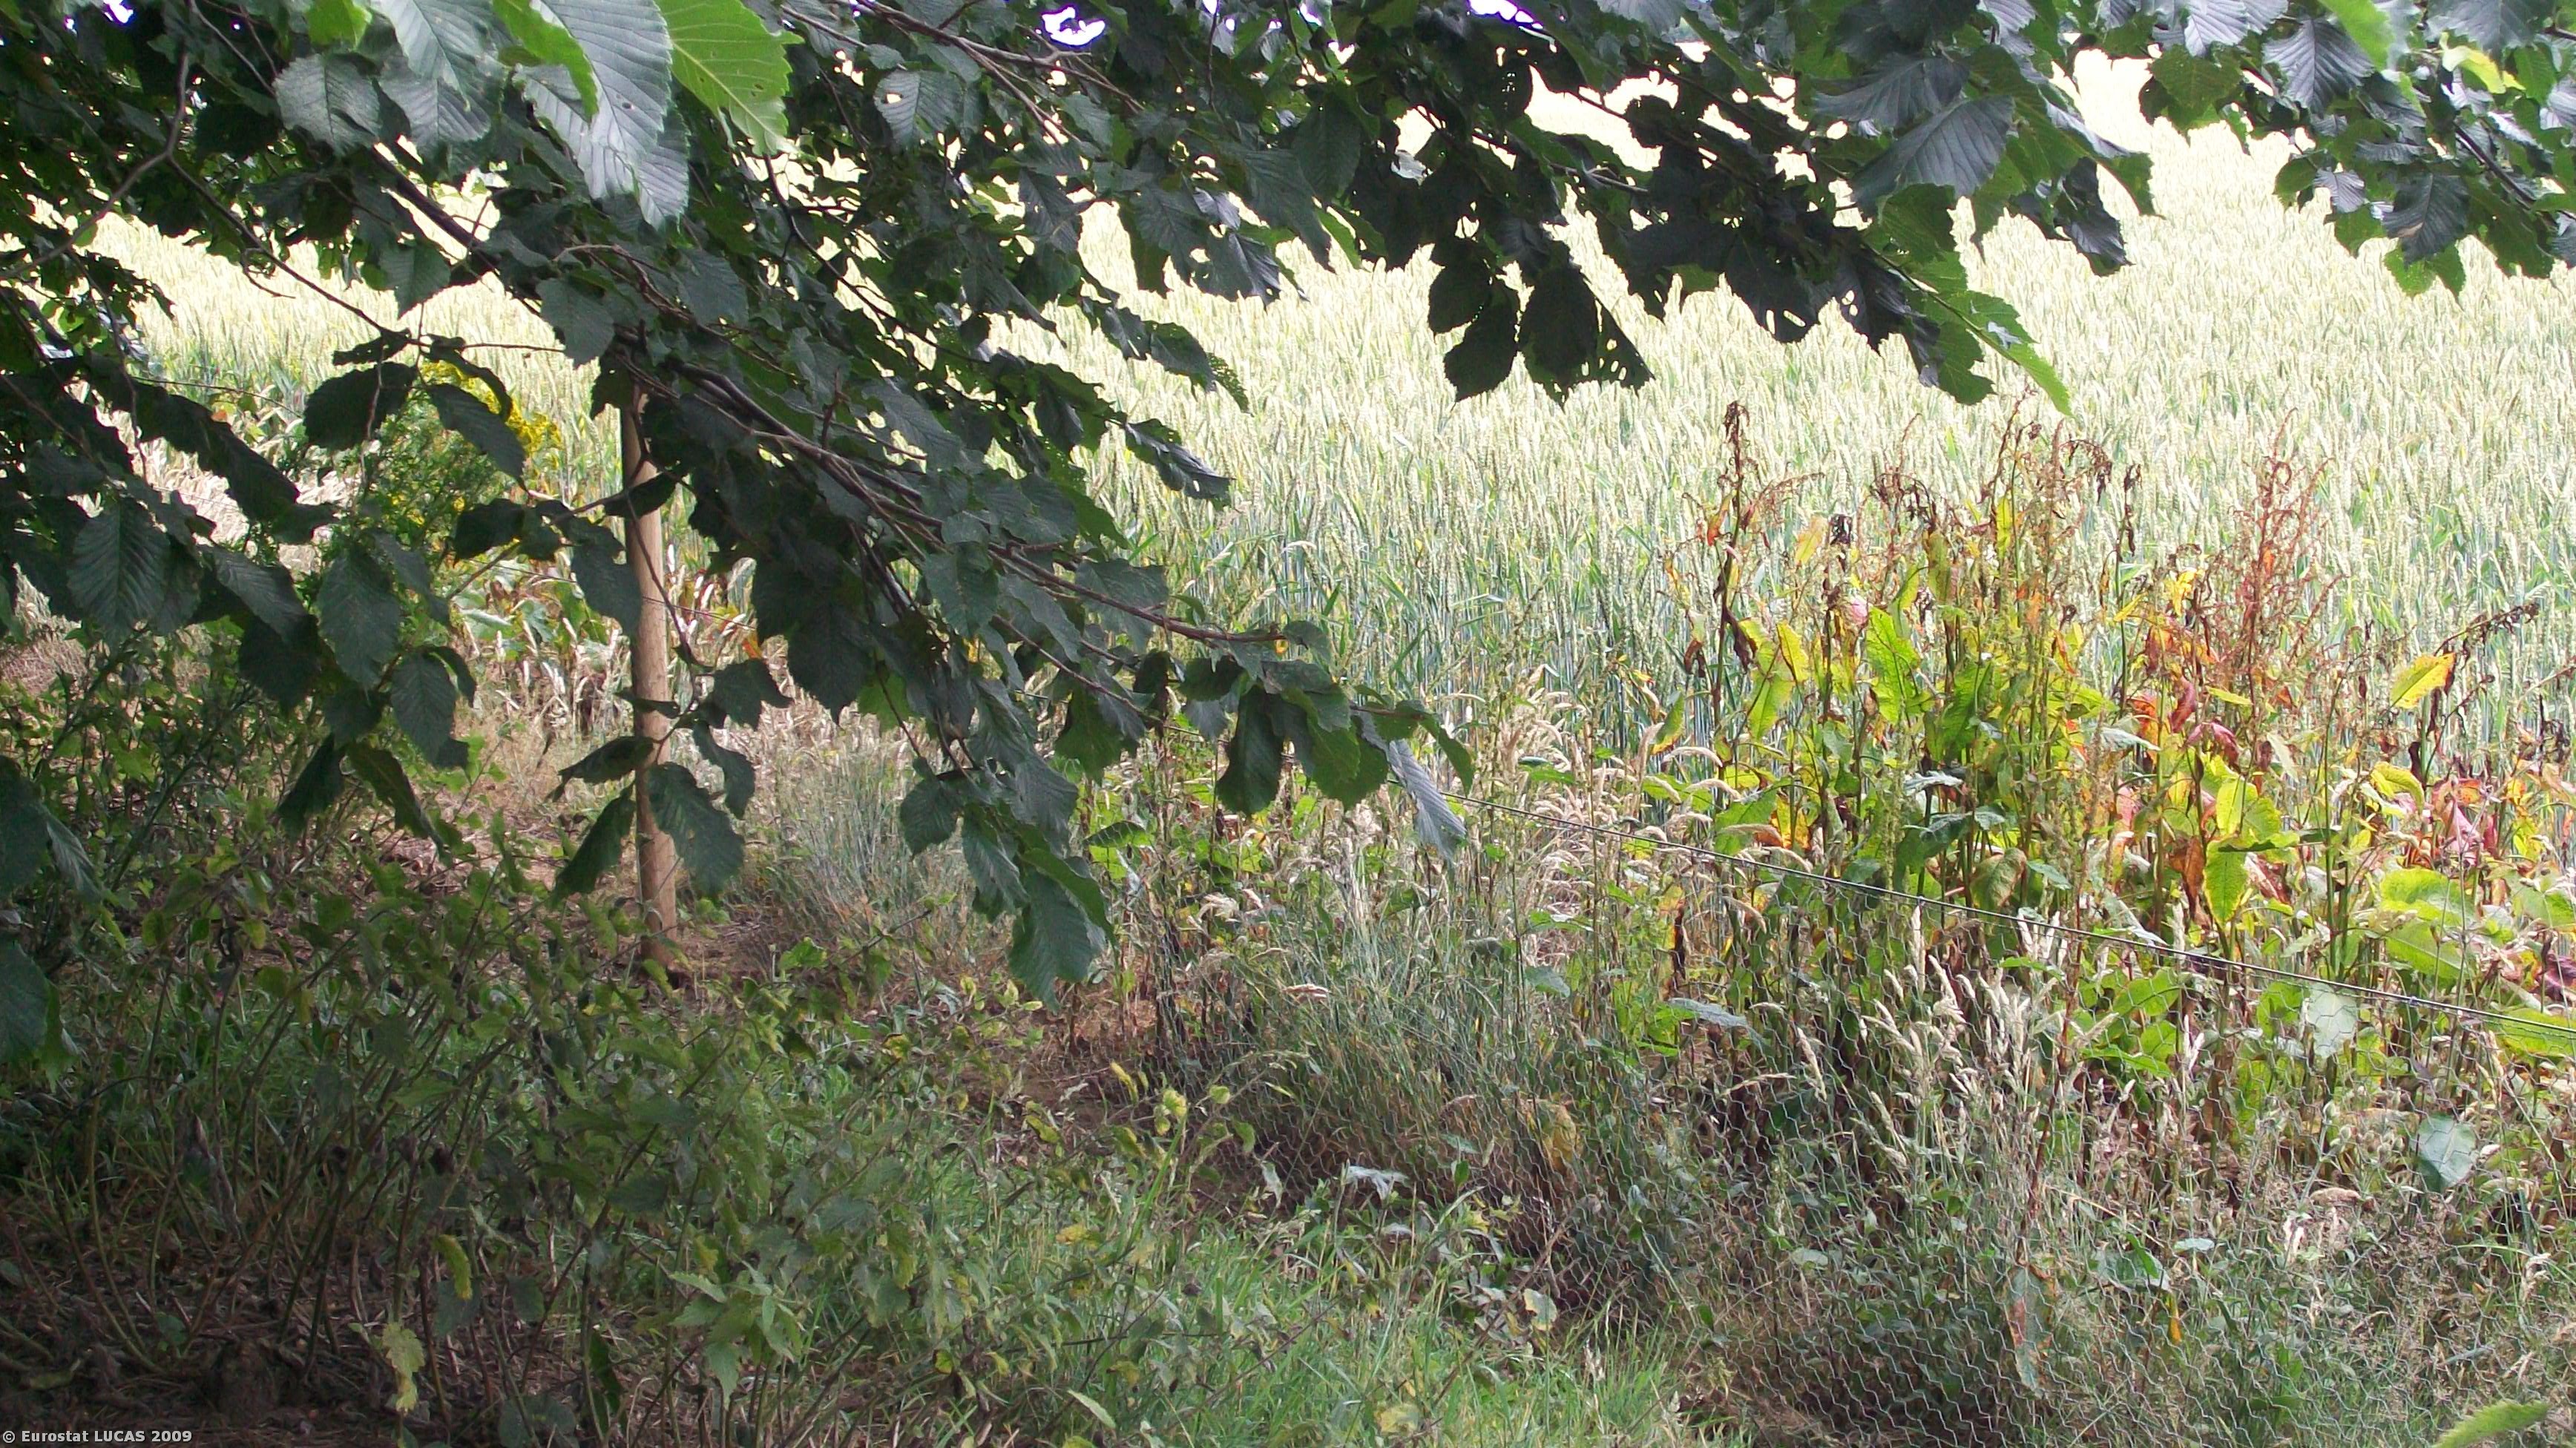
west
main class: Cropland
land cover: Common wheat
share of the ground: > 75 %
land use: Agriculture (excluding fallow land and kitchen gardens)
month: July
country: GB
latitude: 53.5458
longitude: -0.2515
